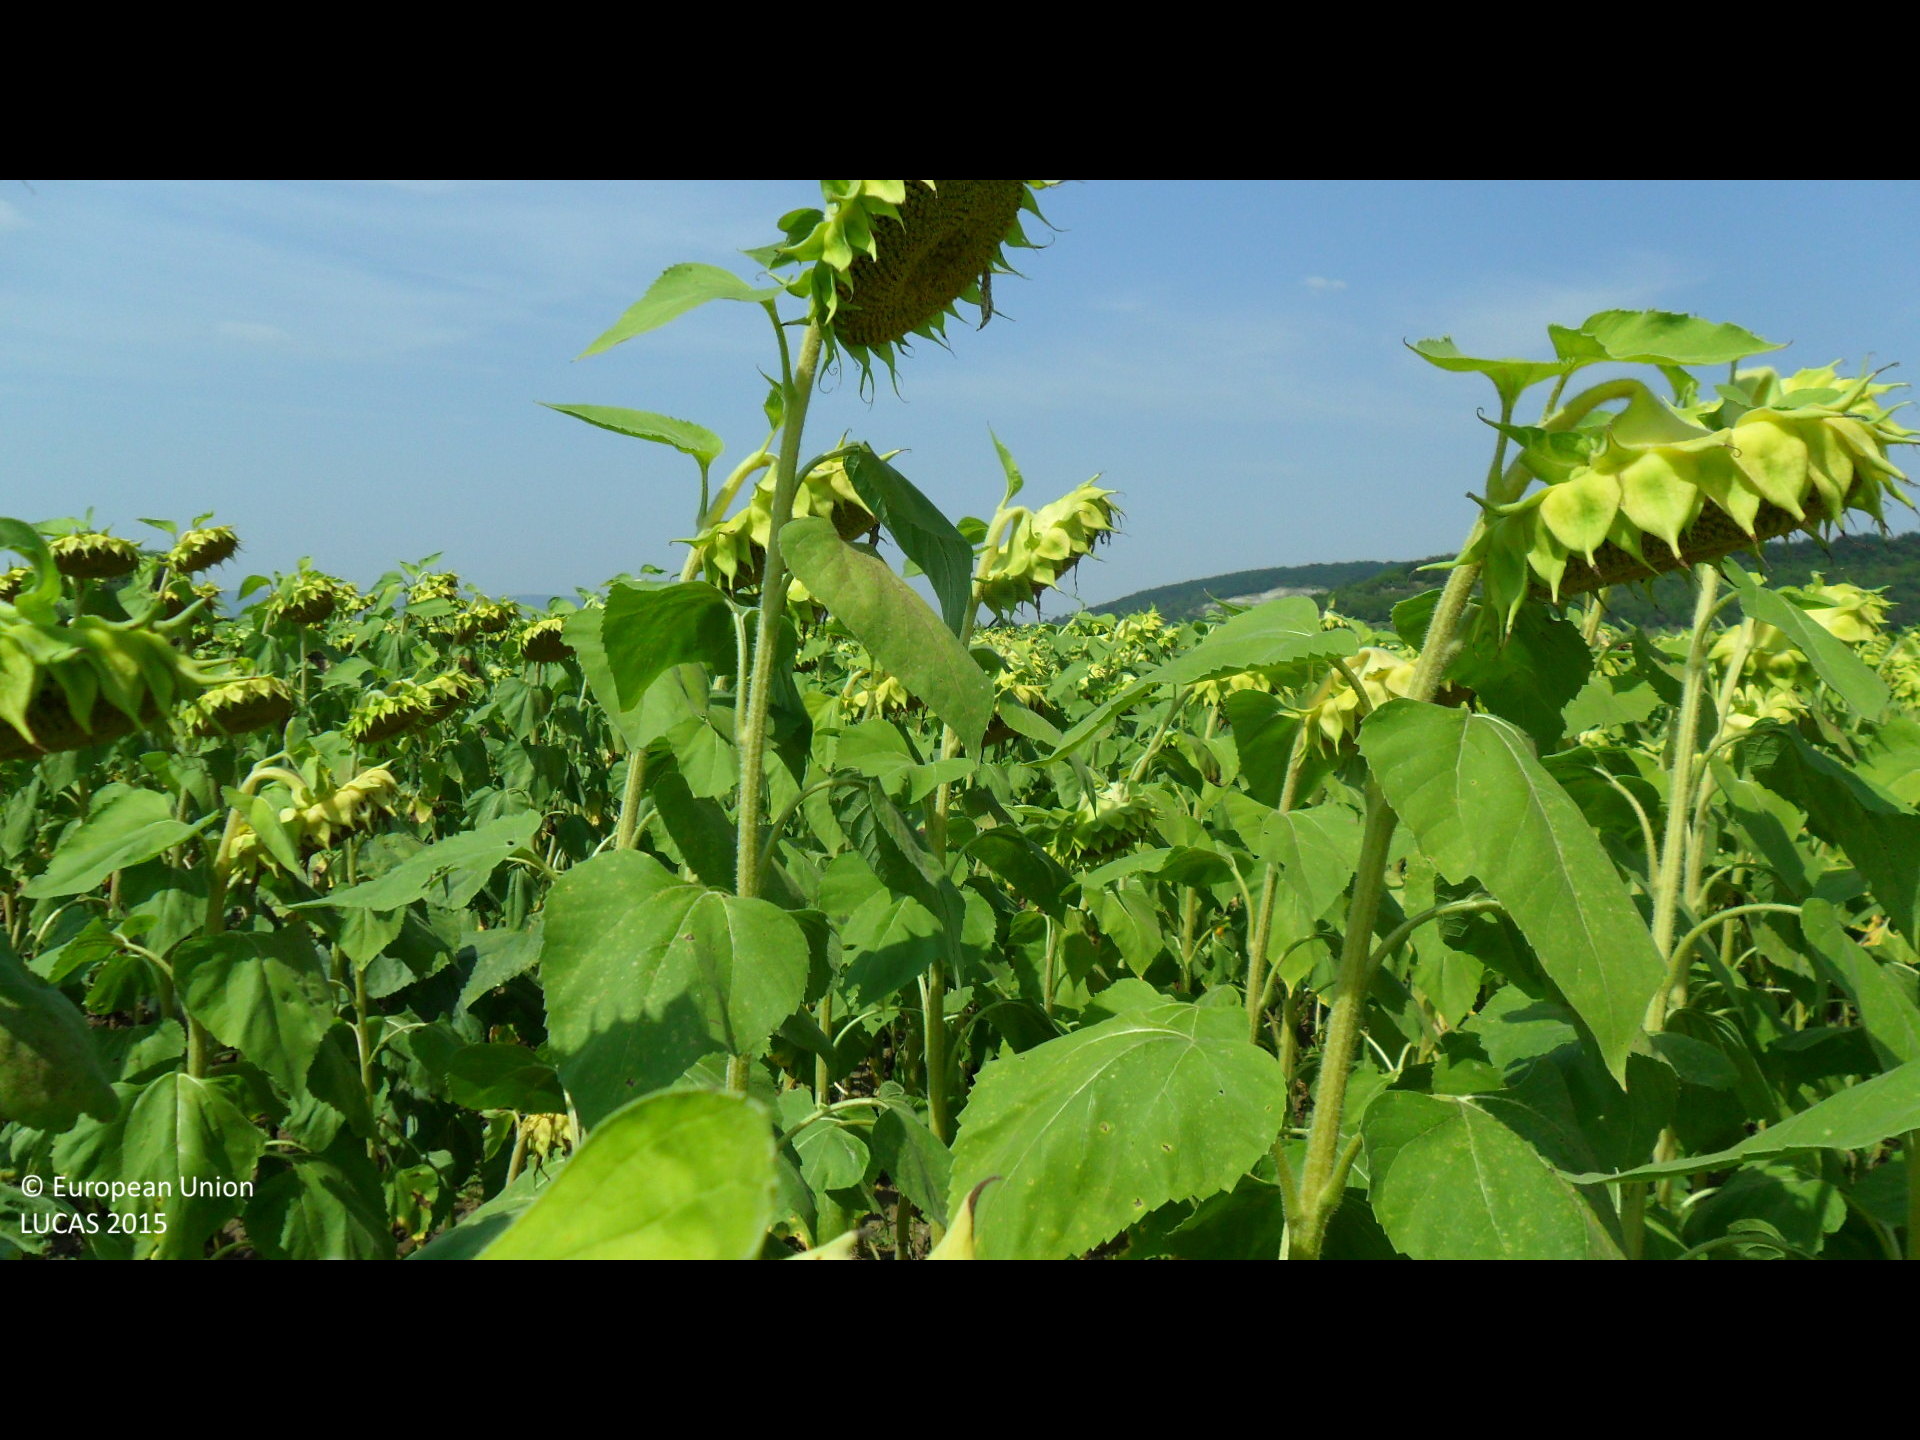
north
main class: Cropland
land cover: Sunflower
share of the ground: > 75 %
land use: Agriculture (excluding fallow land and kitchen gardens)
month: August
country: BG
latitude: 43.3284
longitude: 26.2902
